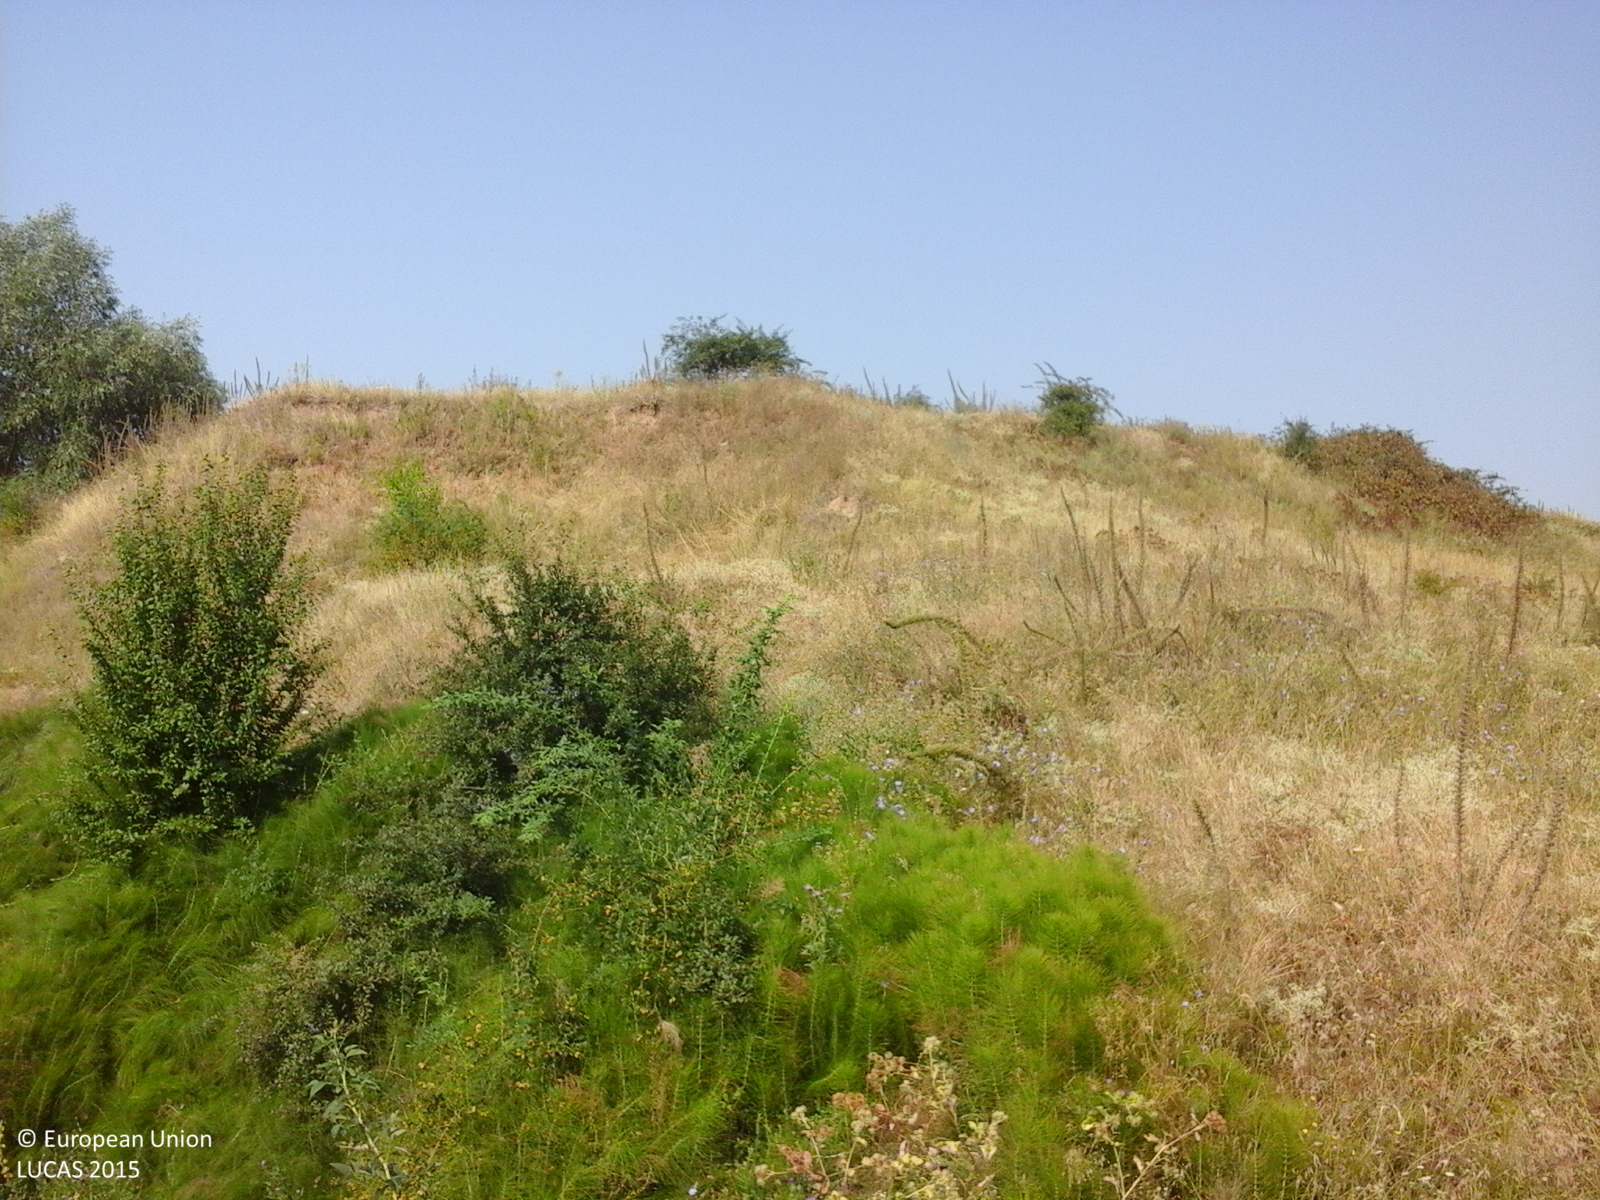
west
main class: Grassland
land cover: Spontaneously vegetated surfaces
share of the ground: > 75 %
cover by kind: herbaceous plants 100 %
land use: Agriculture (excluding fallow land and kitchen gardens)
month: August
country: RO
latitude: 44.5341
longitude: 22.8417
